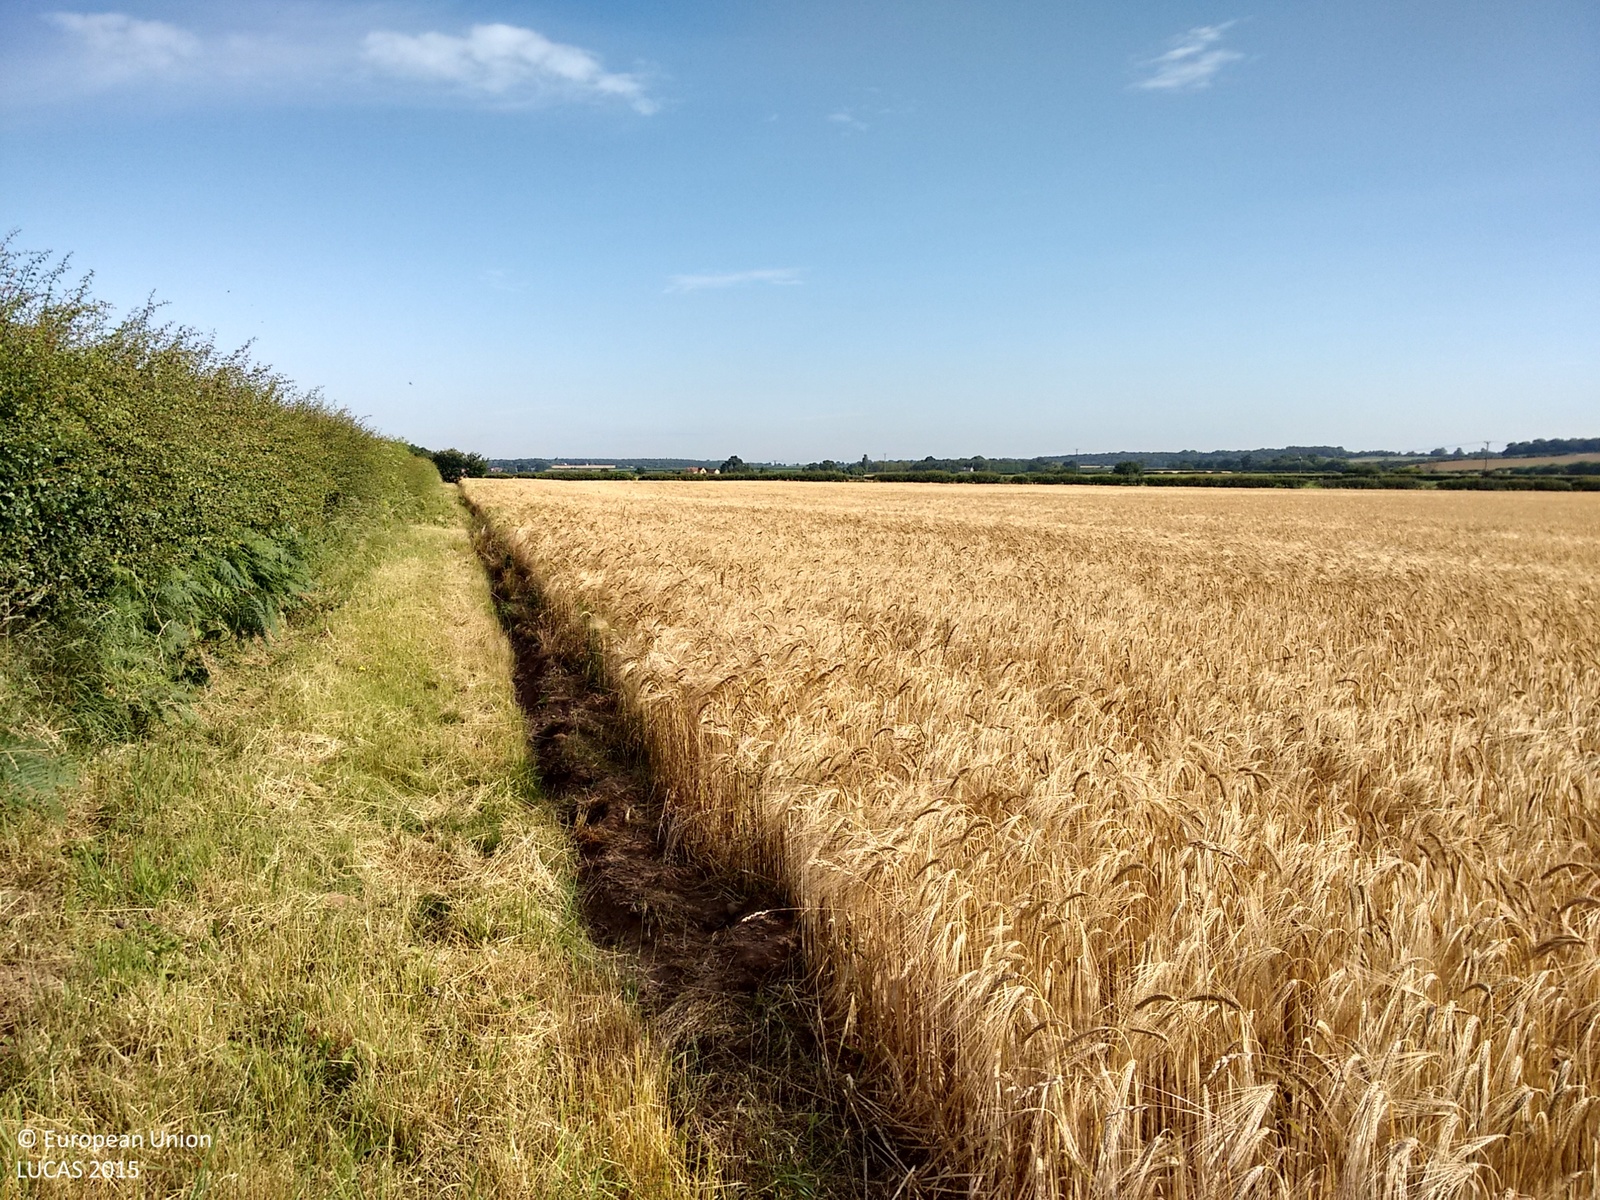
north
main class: Cropland
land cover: Barley
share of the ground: > 75 %
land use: Agriculture (excluding fallow land and kitchen gardens)
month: July
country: GB
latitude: 53.2824
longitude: -0.9774
